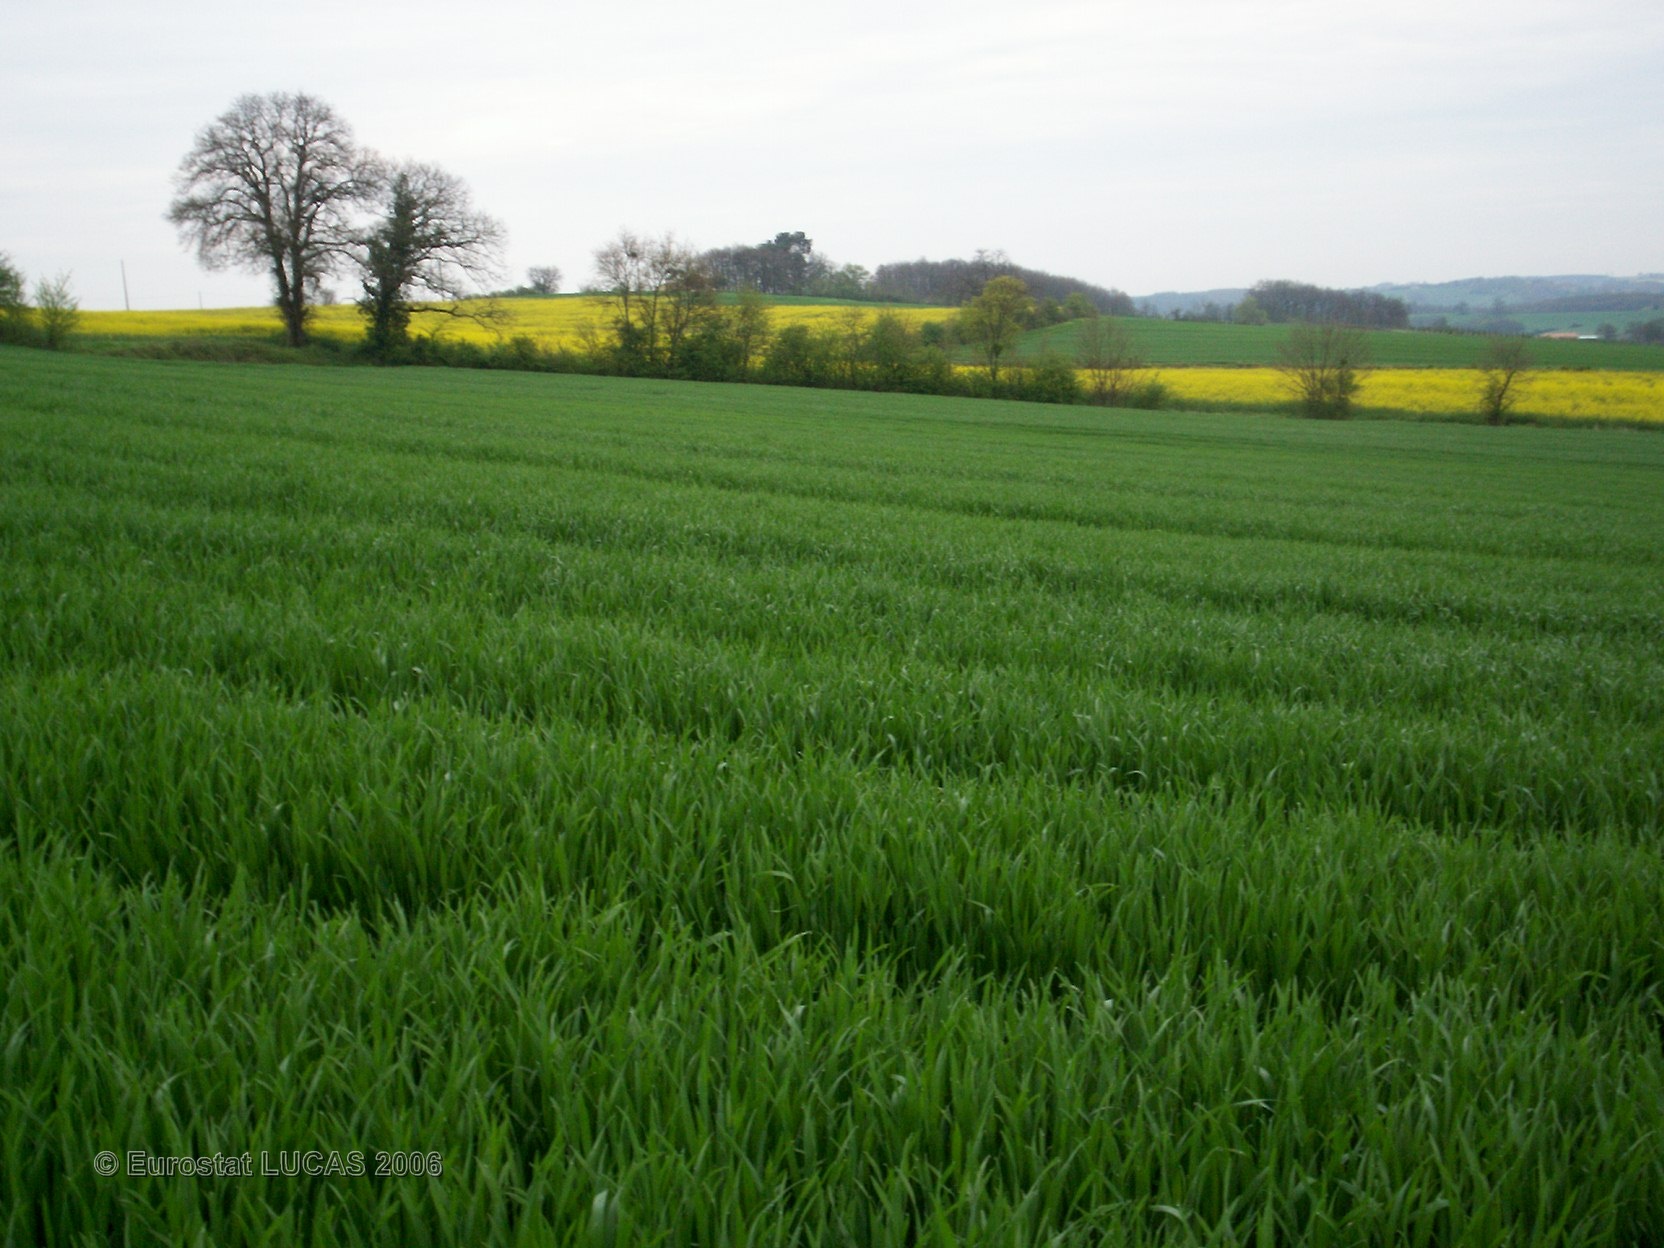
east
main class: Cropland
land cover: Common wheat
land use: Agriculture (excluding fallow land and kitchen gardens)
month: April
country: FR
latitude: 43.6042
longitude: 0.2956
